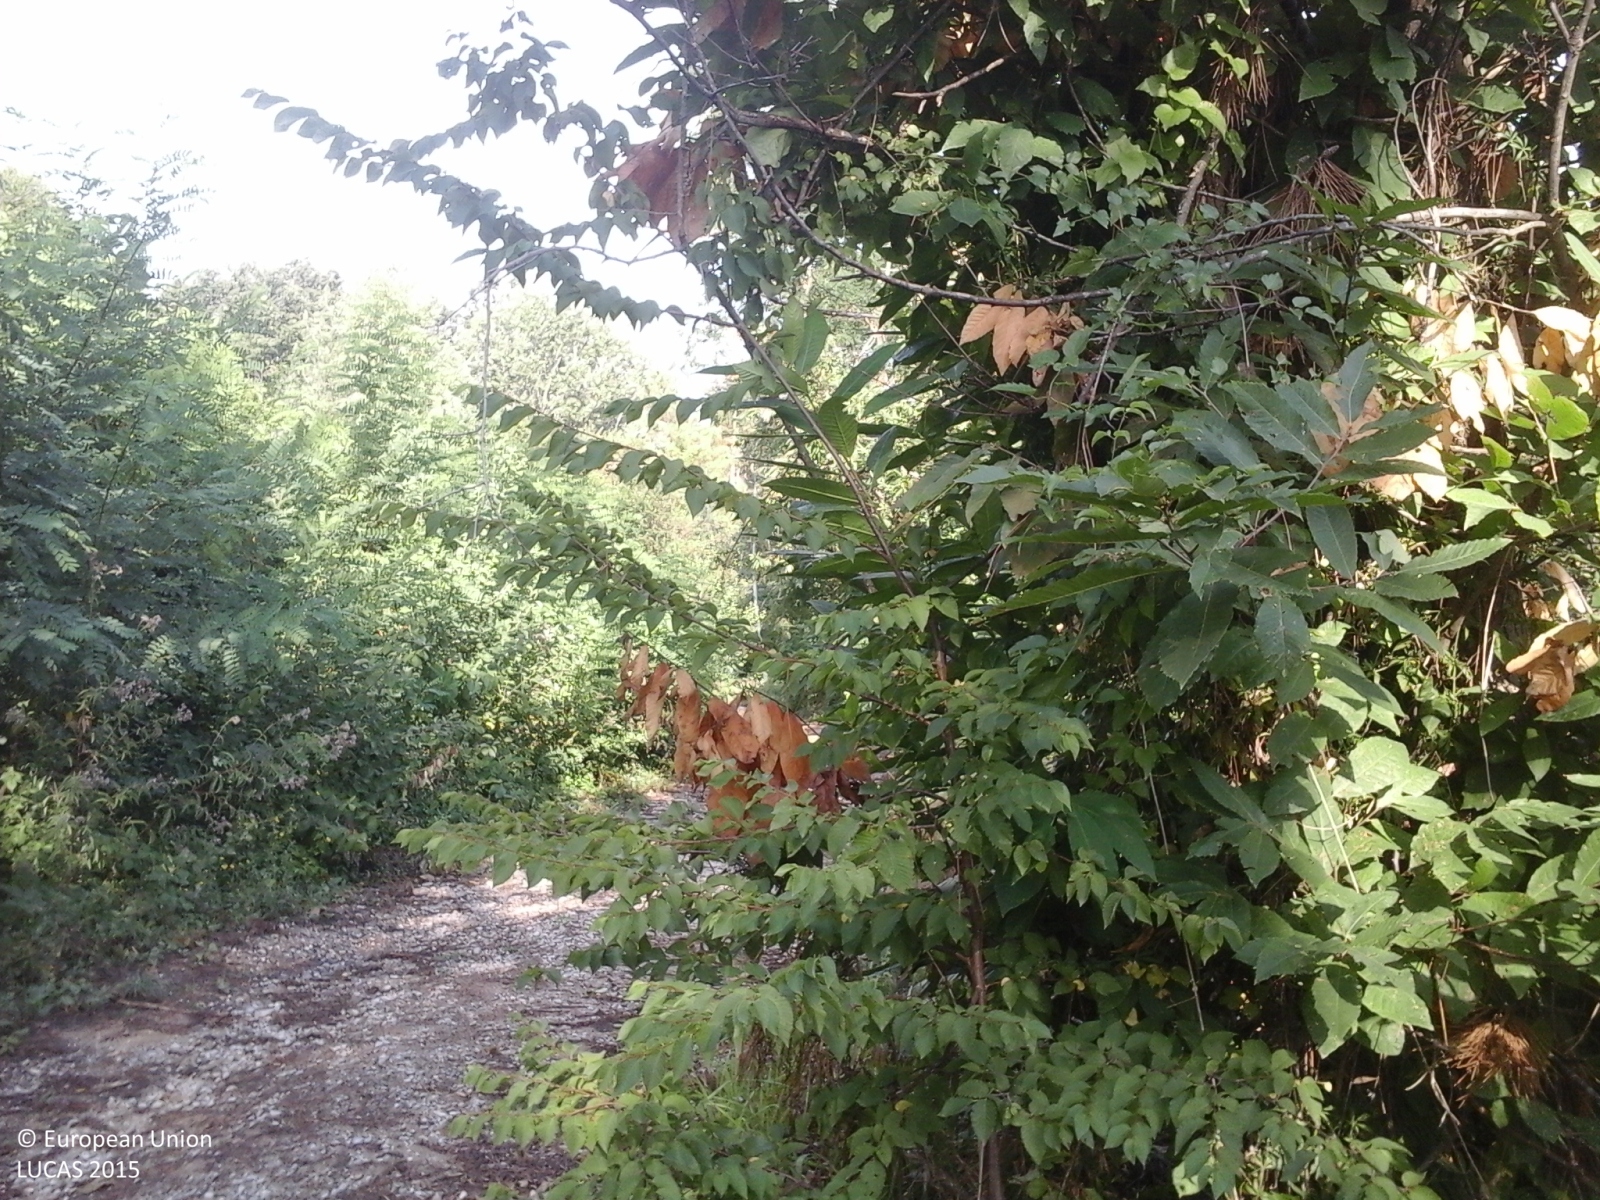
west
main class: Woodland
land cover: Other mixed woodland
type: thermophilous deciduous forest
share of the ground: > 75 %
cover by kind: broadleaved forest trees 60 %, coniferous forest trees 30 %, shrubs 10 %
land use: Forestry
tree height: > 5 m
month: August
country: IT
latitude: 43.8990
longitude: 10.3353
